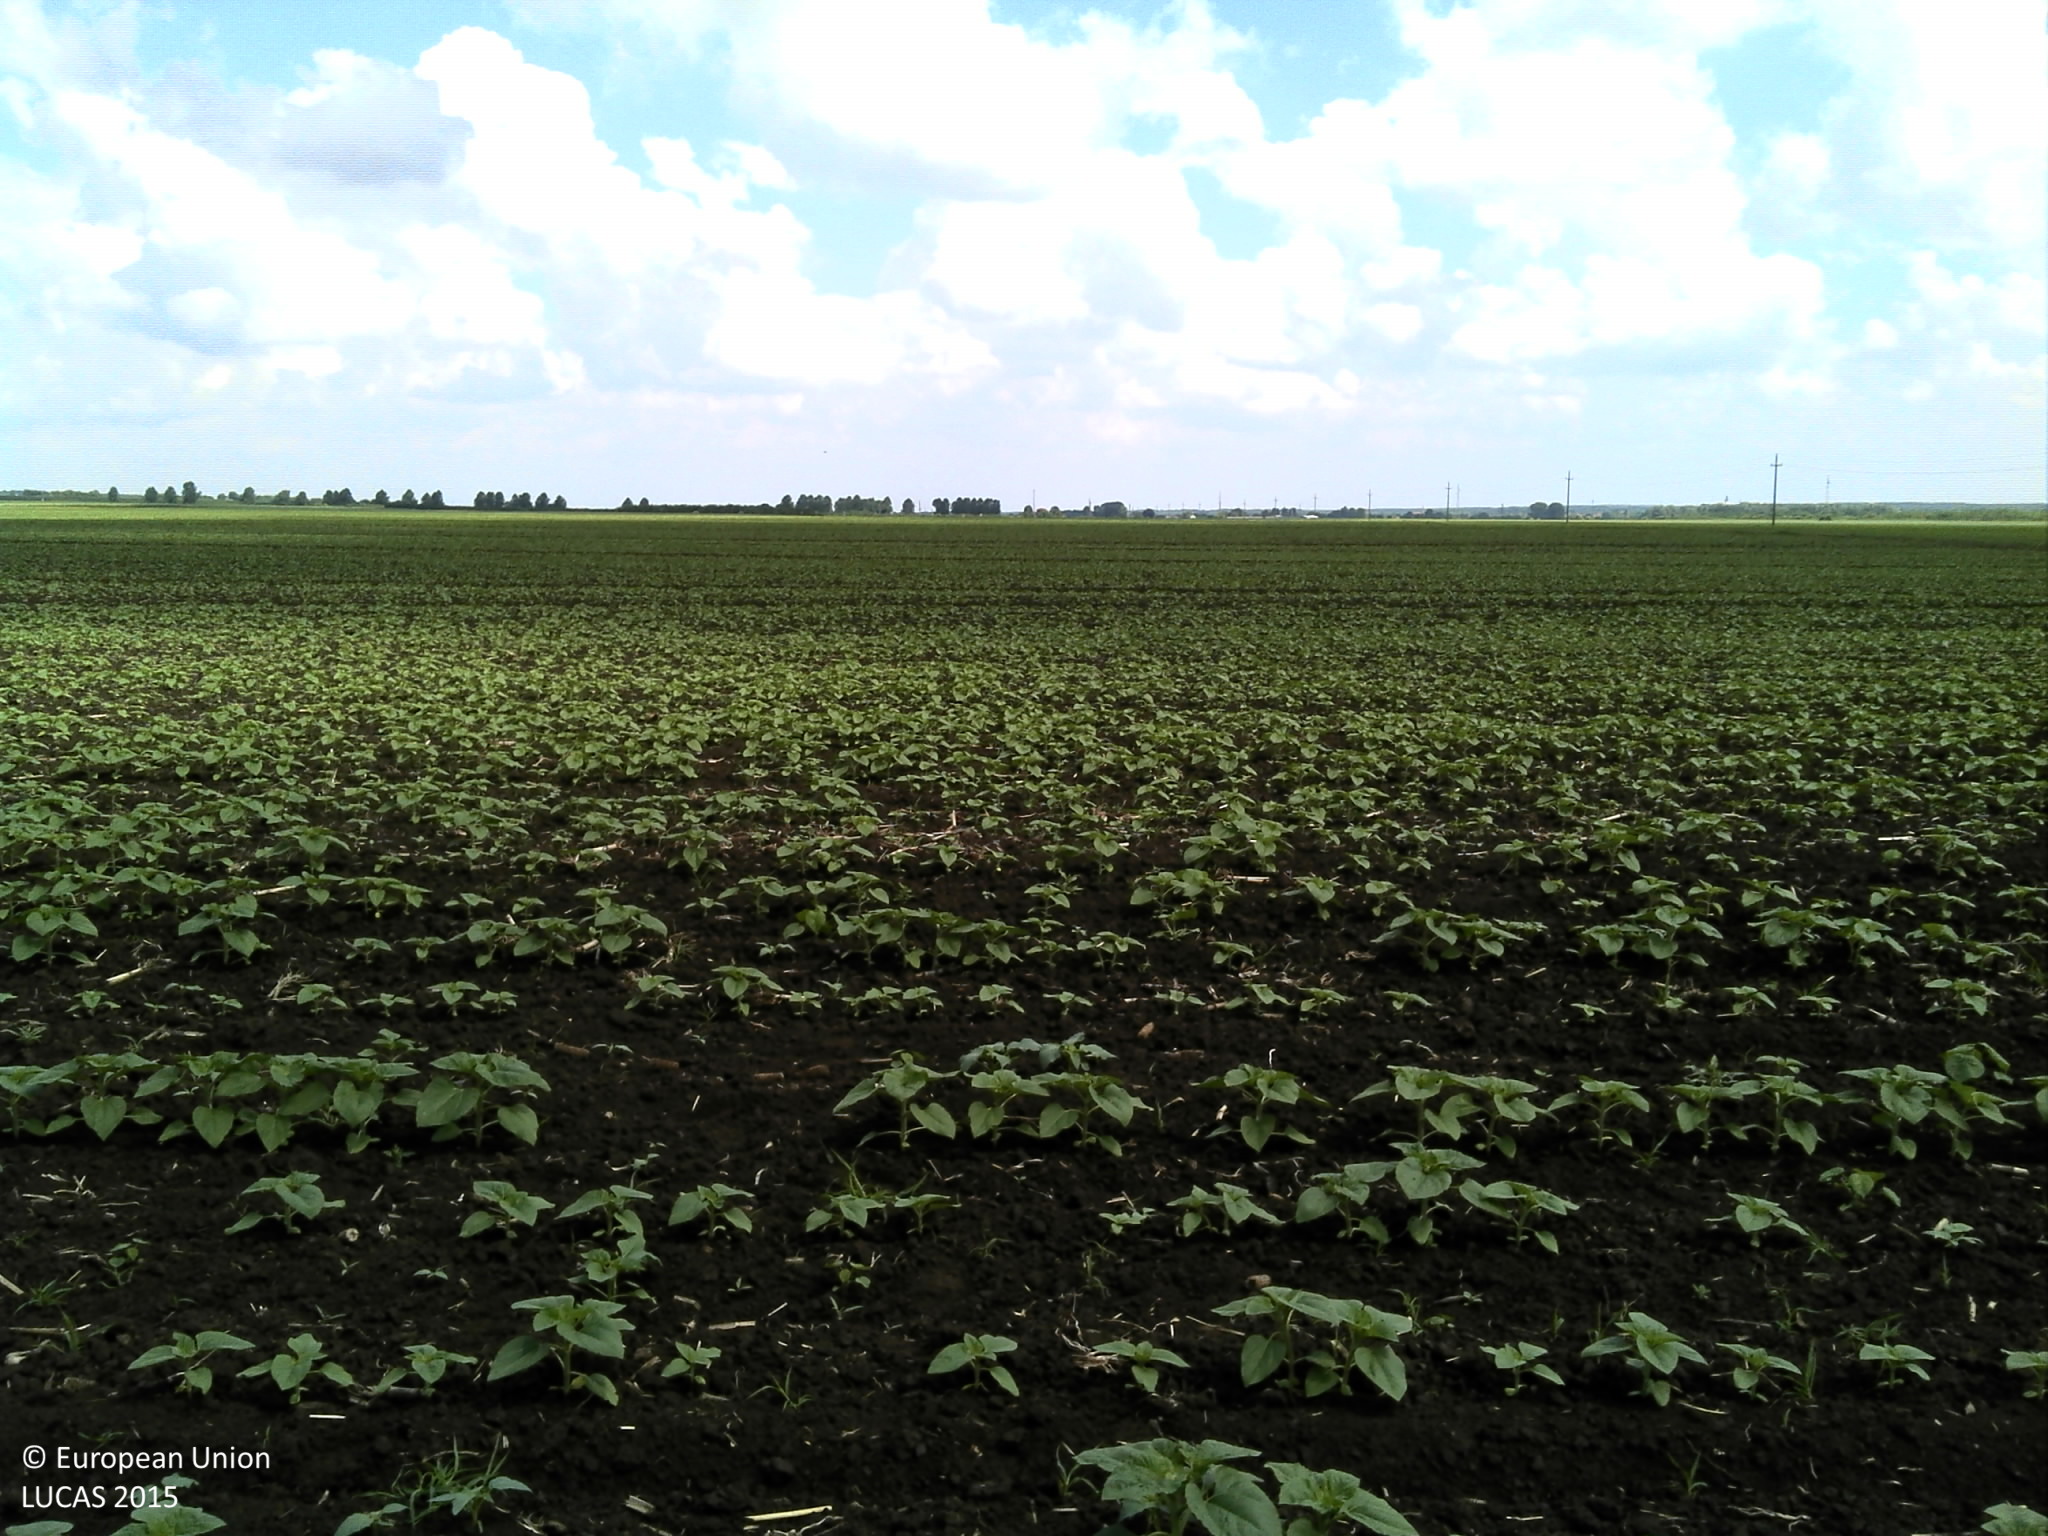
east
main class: Cropland
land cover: Sunflower
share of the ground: 10 - 25 %
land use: Agriculture (excluding fallow land and kitchen gardens)
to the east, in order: Sunflower
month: May
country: HR
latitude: 45.5060
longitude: 18.9299
